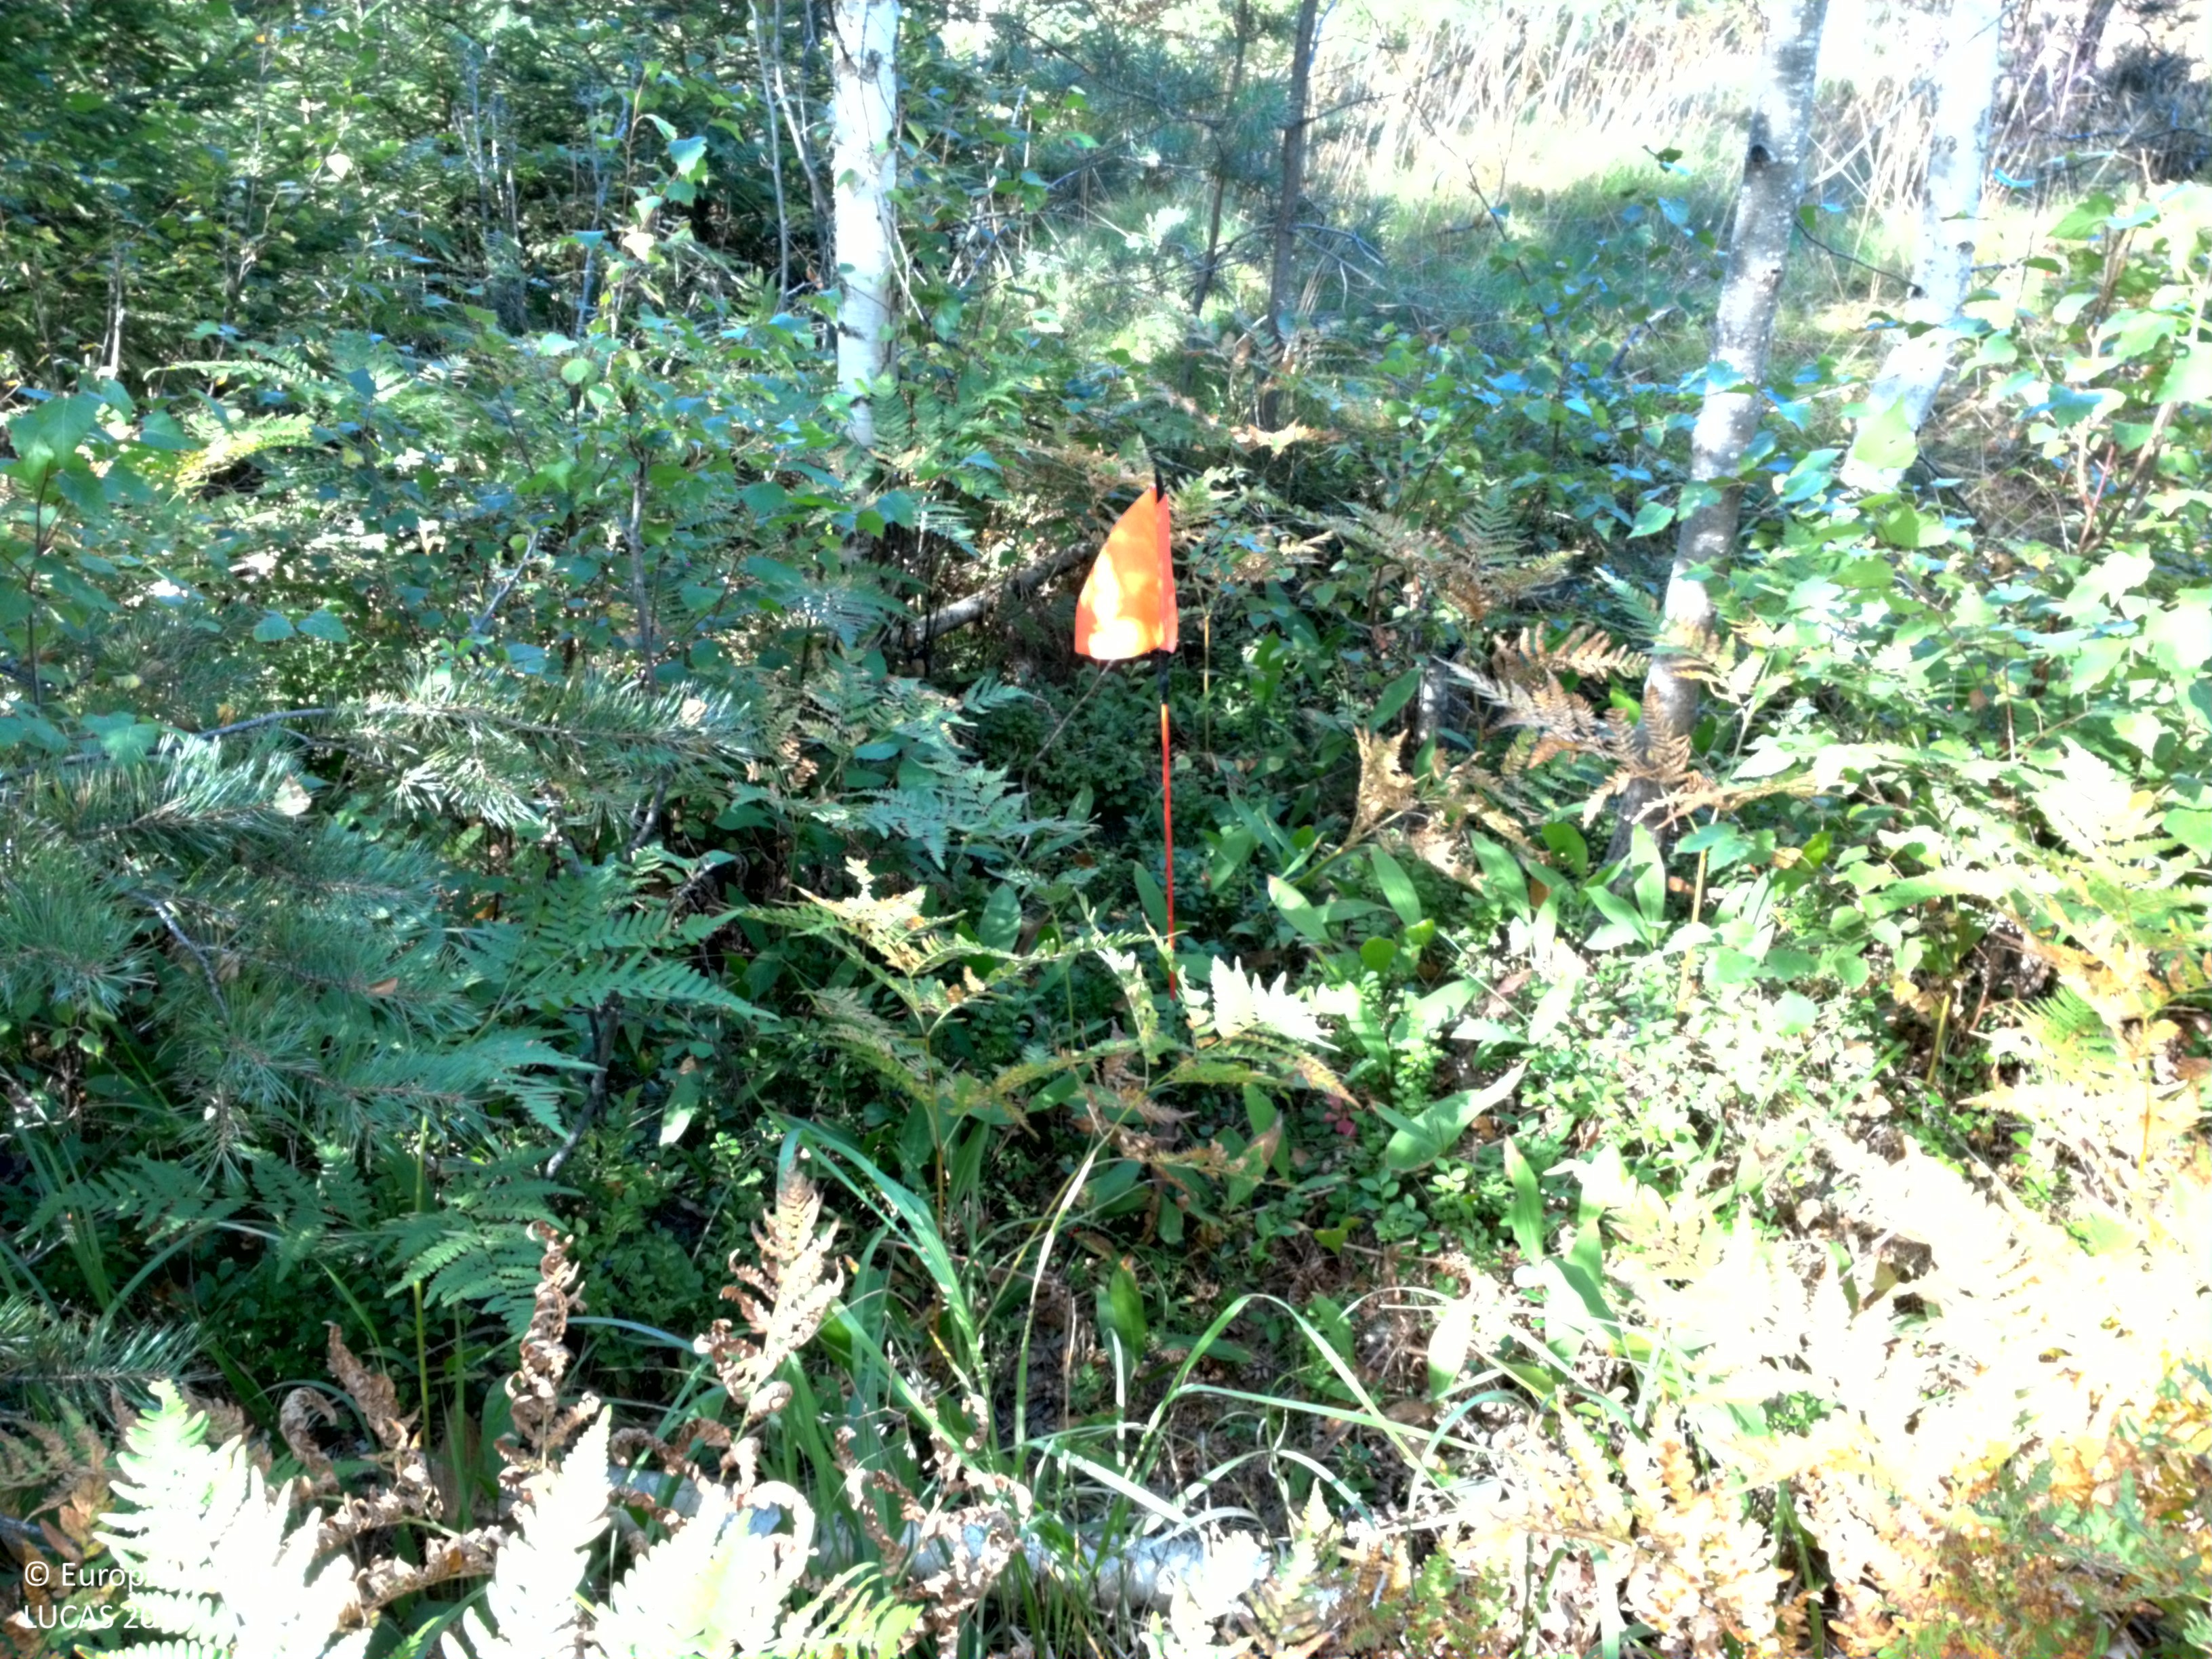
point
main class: Woodland
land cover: Pine dominated mixed woodland
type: boreal forest
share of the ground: 50 - 75 %
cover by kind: coniferous forest trees 30 %, herbaceous plants 30 %, broadleaved forest trees 25 %, shrubs 15 %
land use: Forestry
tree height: < 5 m
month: August
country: SE
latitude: 60.0427
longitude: 18.0202
